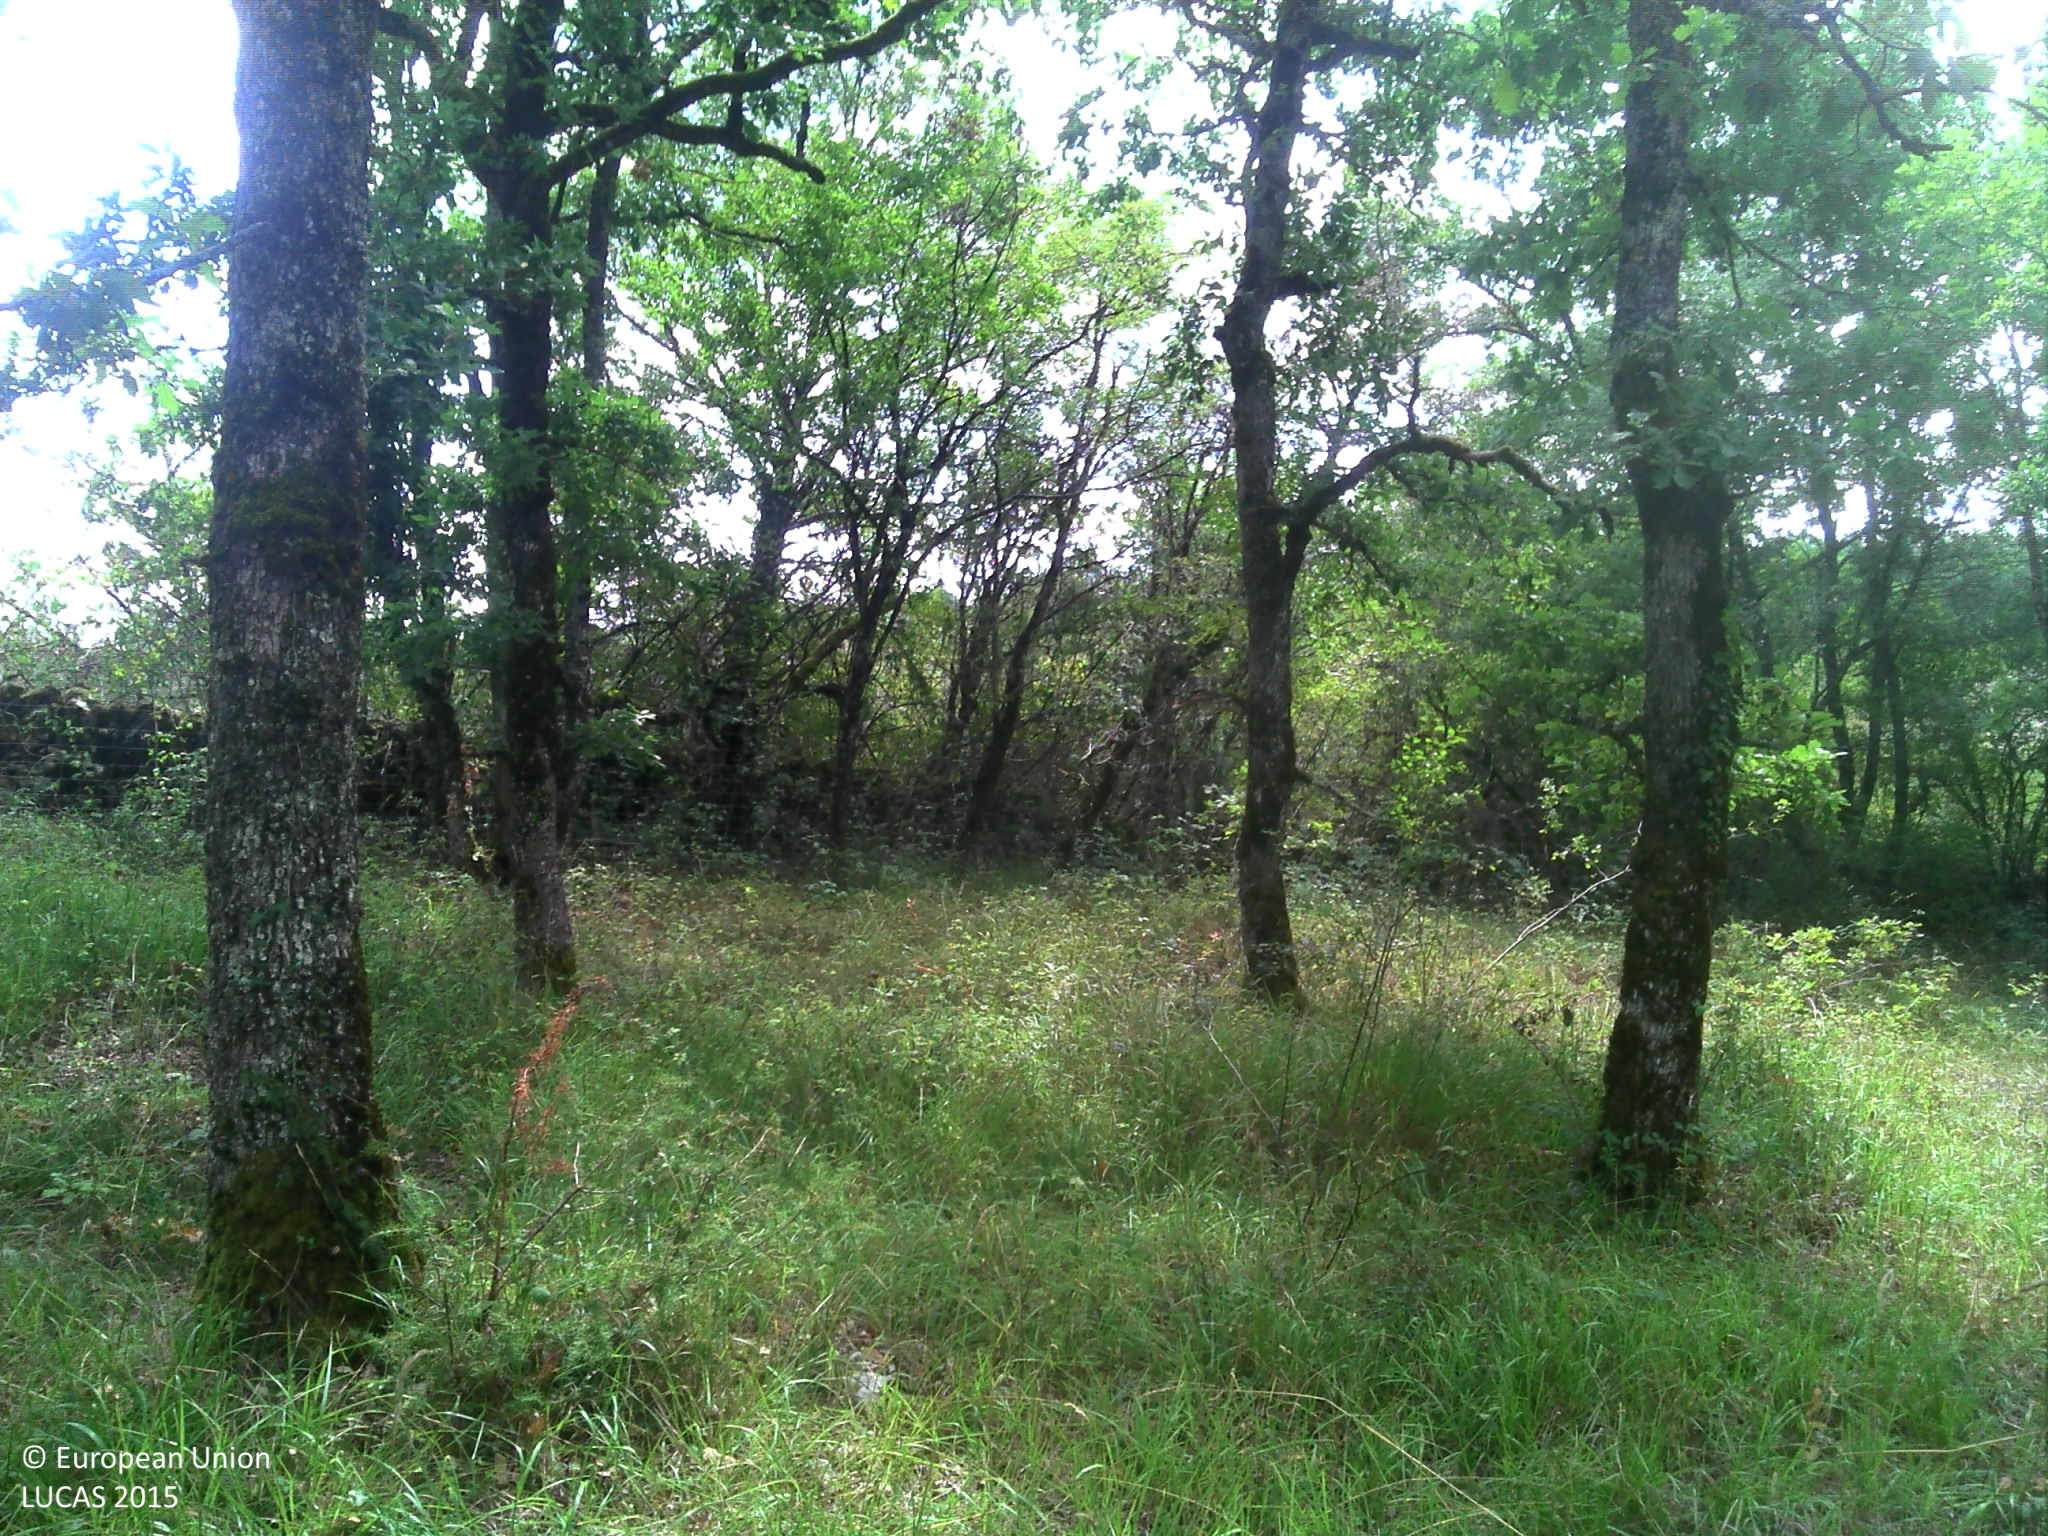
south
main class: Woodland
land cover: Broadleaved woodland
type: thermophilous deciduous forest
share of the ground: > 75 %
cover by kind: broadleaved forest trees 80 %, shrubs 10 %, herbaceous plants 10 %
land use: Forestry
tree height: > 5 m
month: August
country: FR
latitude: 44.8579
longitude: 1.7851
